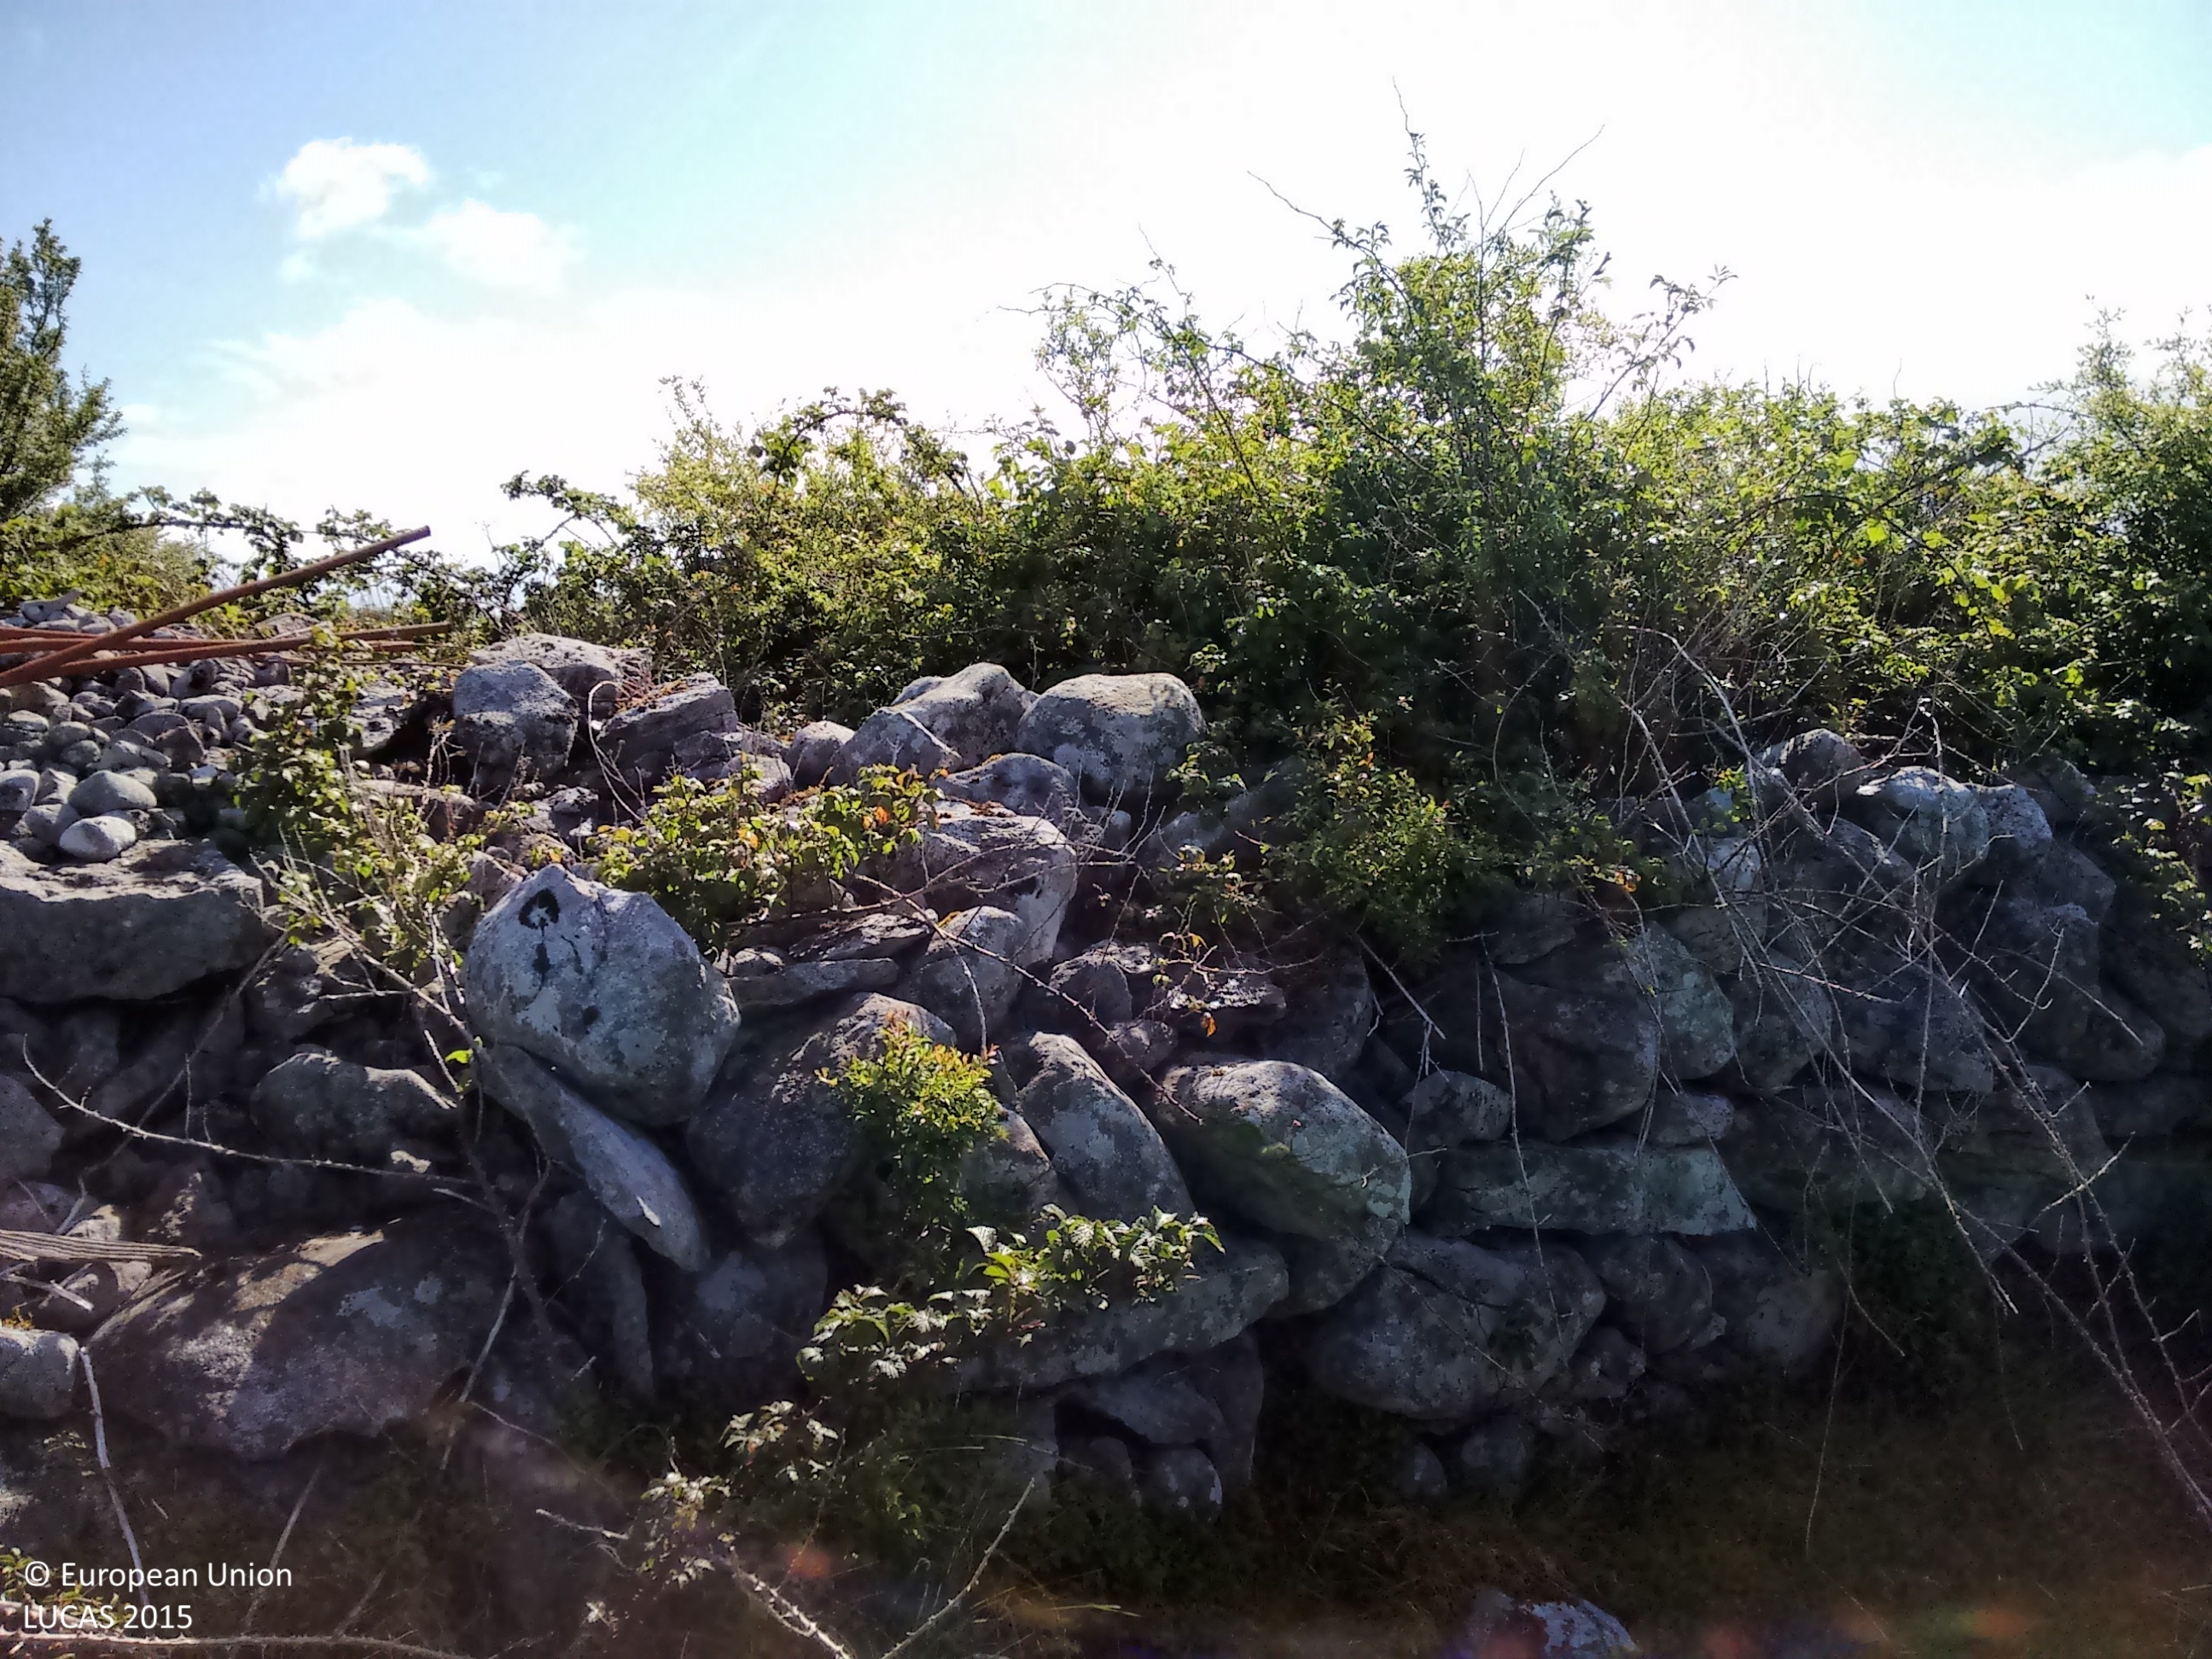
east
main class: Grassland
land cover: Grassland without tree/shrub cover
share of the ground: > 75 %
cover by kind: herbaceous plants 100 %
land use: Agriculture (excluding fallow land and kitchen gardens)
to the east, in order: Grassland without tree/shrub cover; Single bushes/trees; Dry stone walls; Single bushes/trees; Grassland without tree/shrub cover; Abandoned hedges; Grassland without tree/shrub cover; Abandoned hedges; Dry stone walls; Abandoned hedges; Grassland without tree/shrub cover; Shrubland without tree cover; Dry stone walls; Shrubland with sparse tree cover
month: May
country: IE
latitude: 53.1487
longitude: -8.9144
